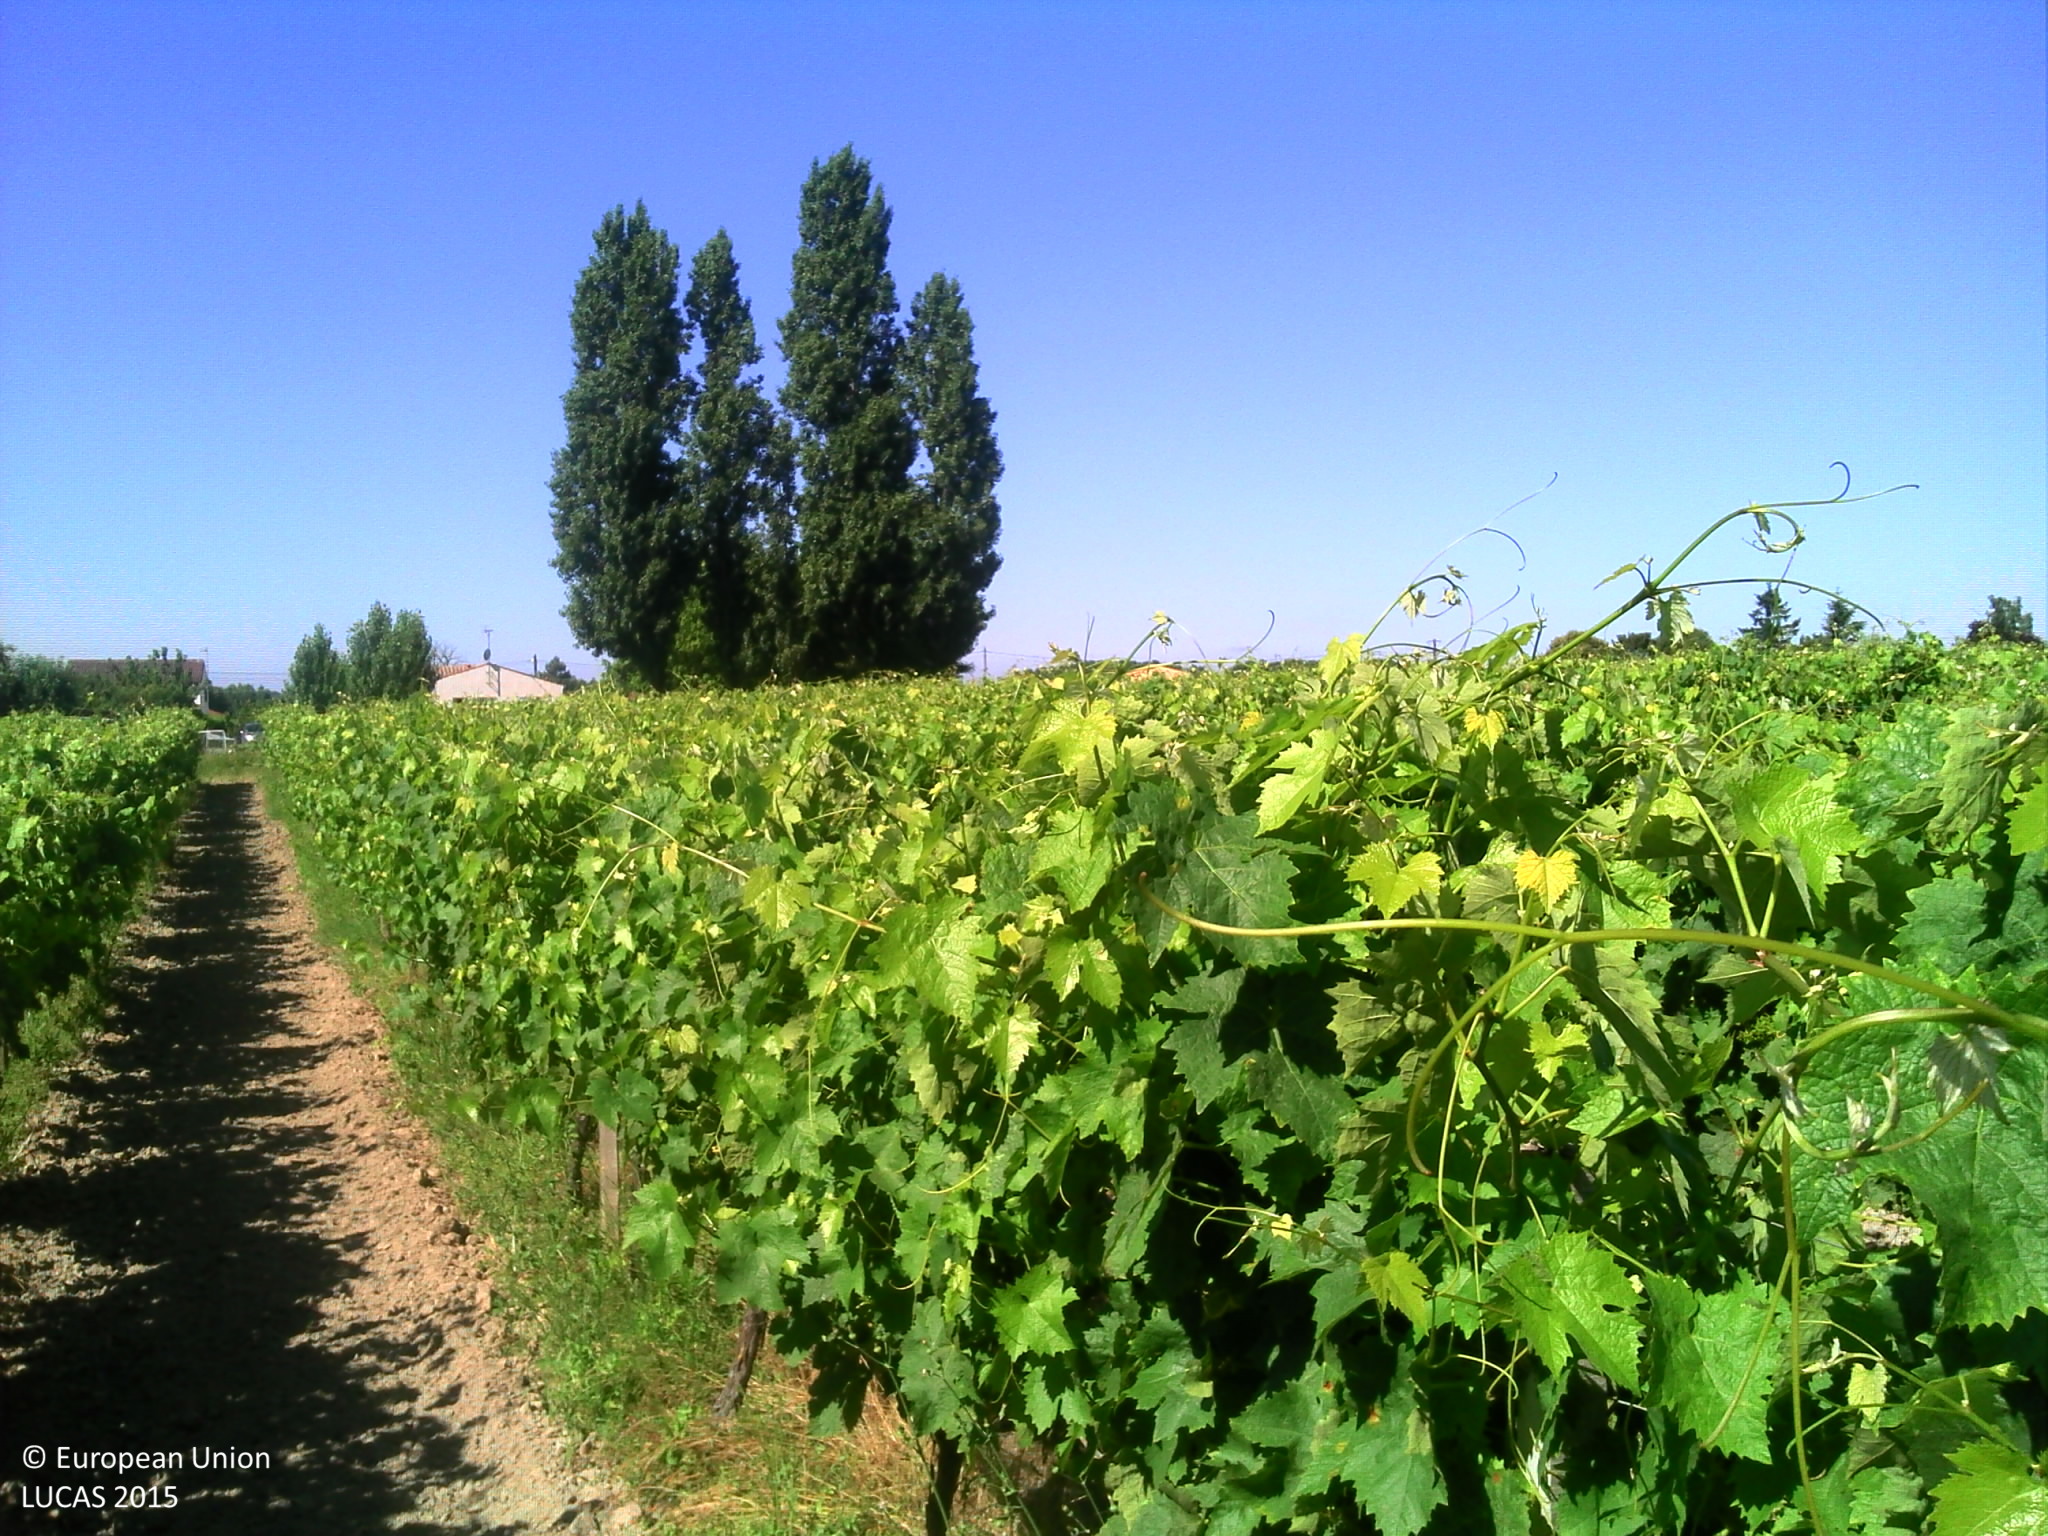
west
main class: Cropland
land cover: Vineyards
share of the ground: 25 - 50 %
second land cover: Other bare soil
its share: > 75 %
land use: Agriculture (excluding fallow land and kitchen gardens)
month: June
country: FR
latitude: 45.6377
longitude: -0.8146
